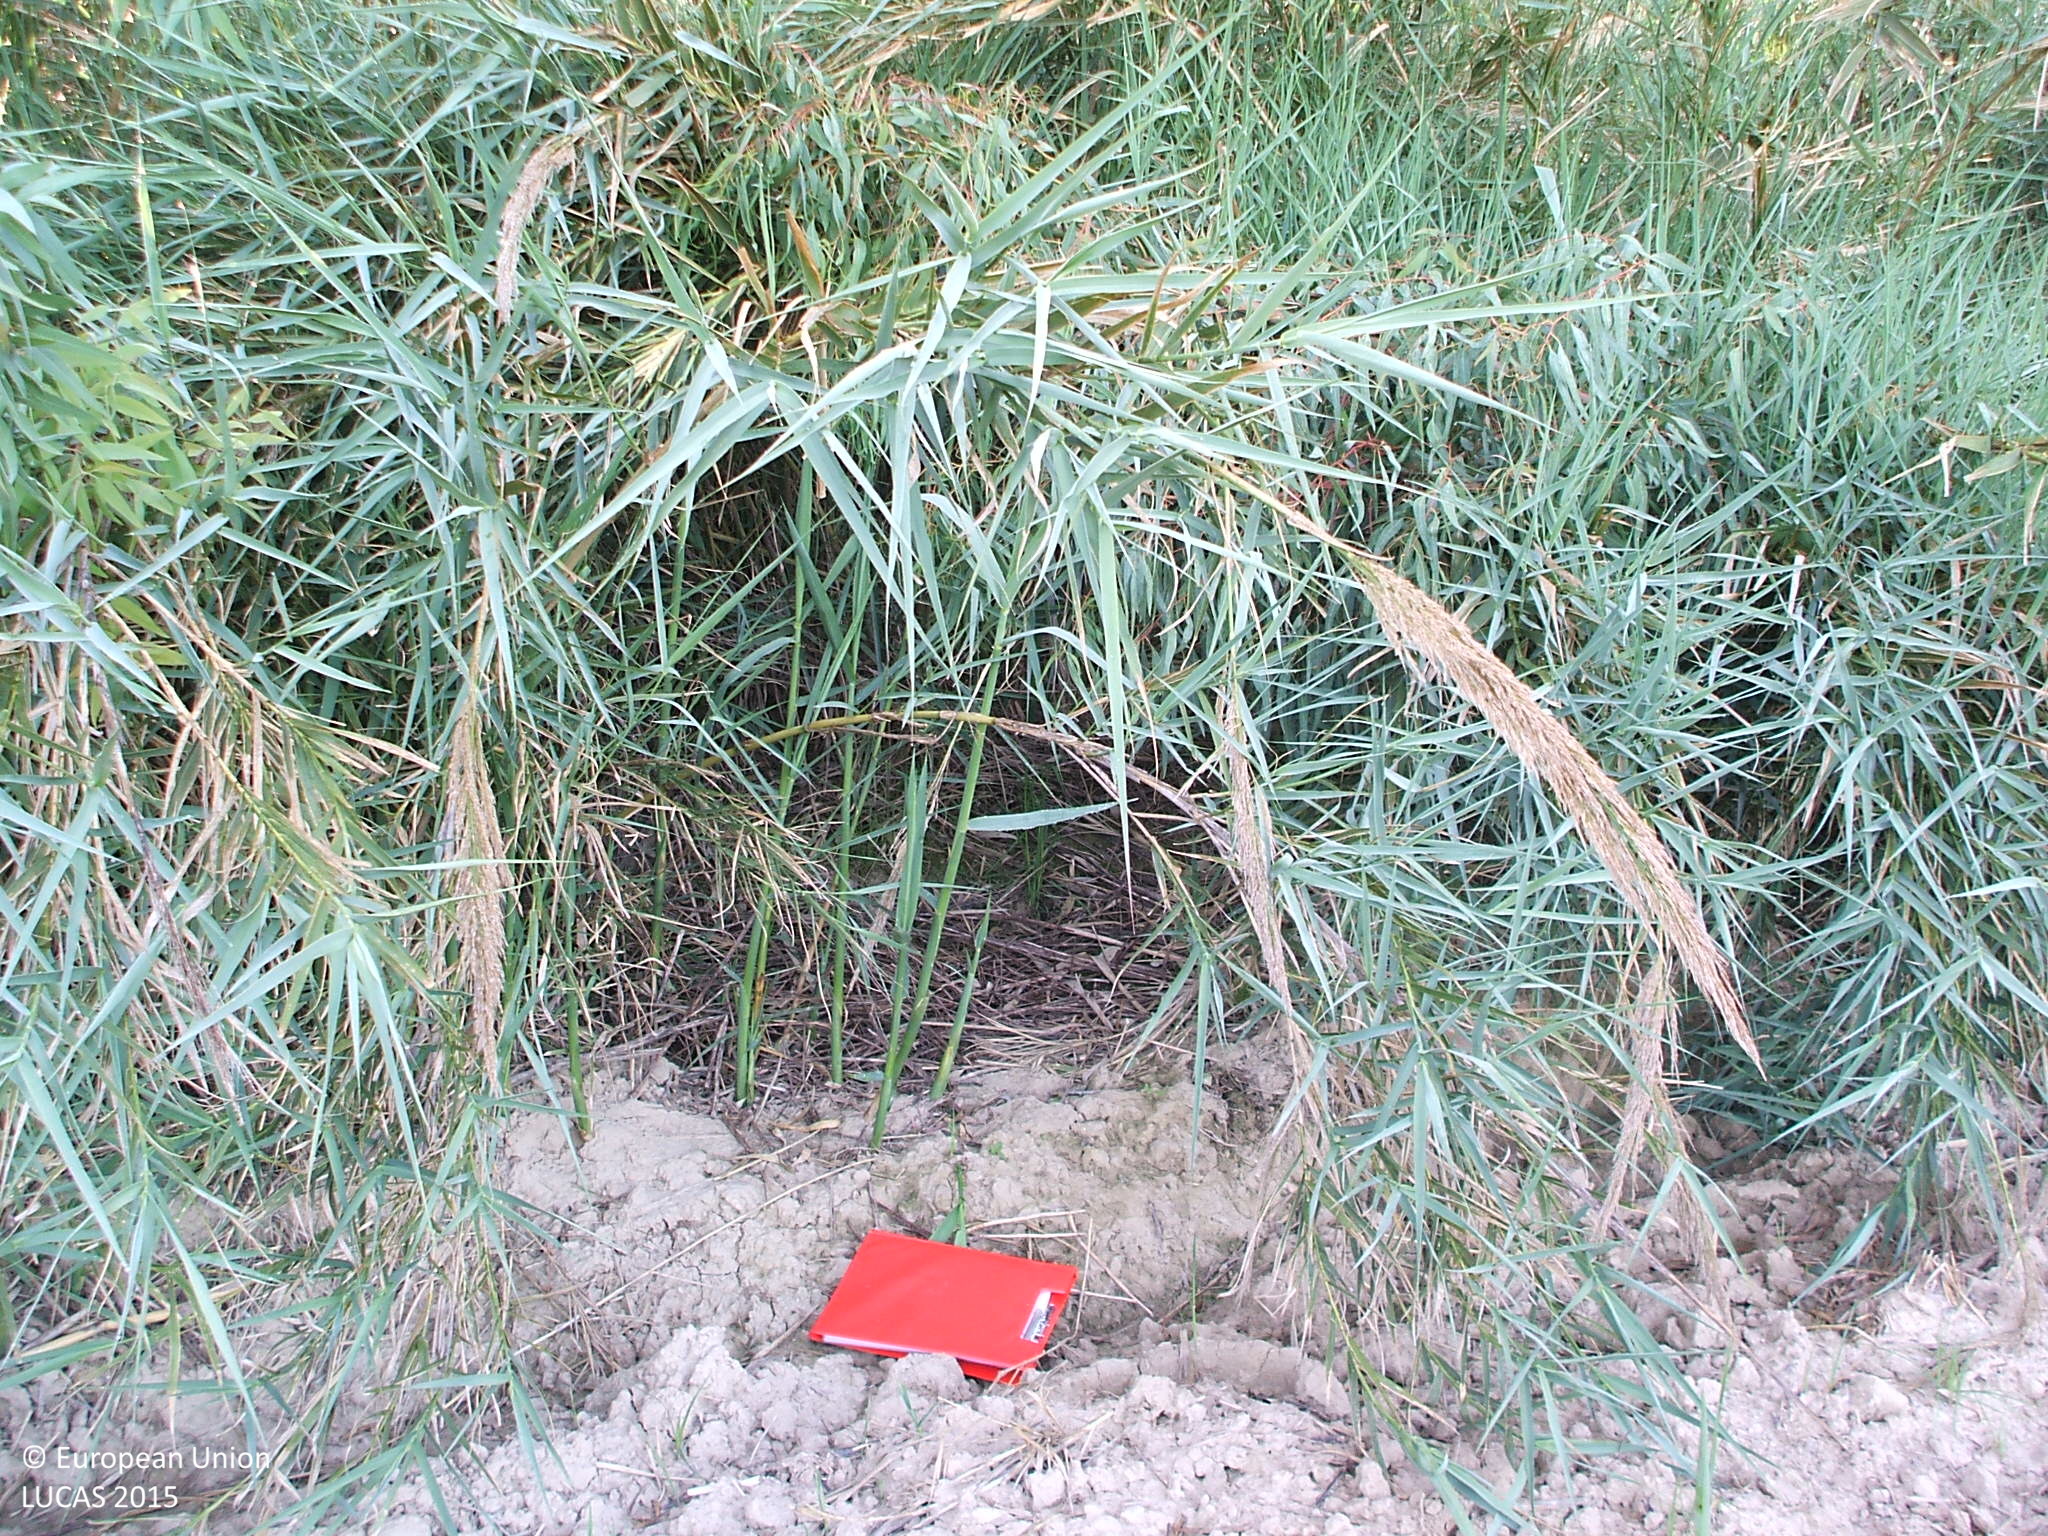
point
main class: Woodland
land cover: Broadleaved woodland
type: exotic forest
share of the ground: 10 - 25 %
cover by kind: shrubs 85 %, broadleaved forest trees 15 %
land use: Semi-natural and natural areas not in use
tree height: > 5 m
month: April
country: ES
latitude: 37.6088
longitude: -5.6205
